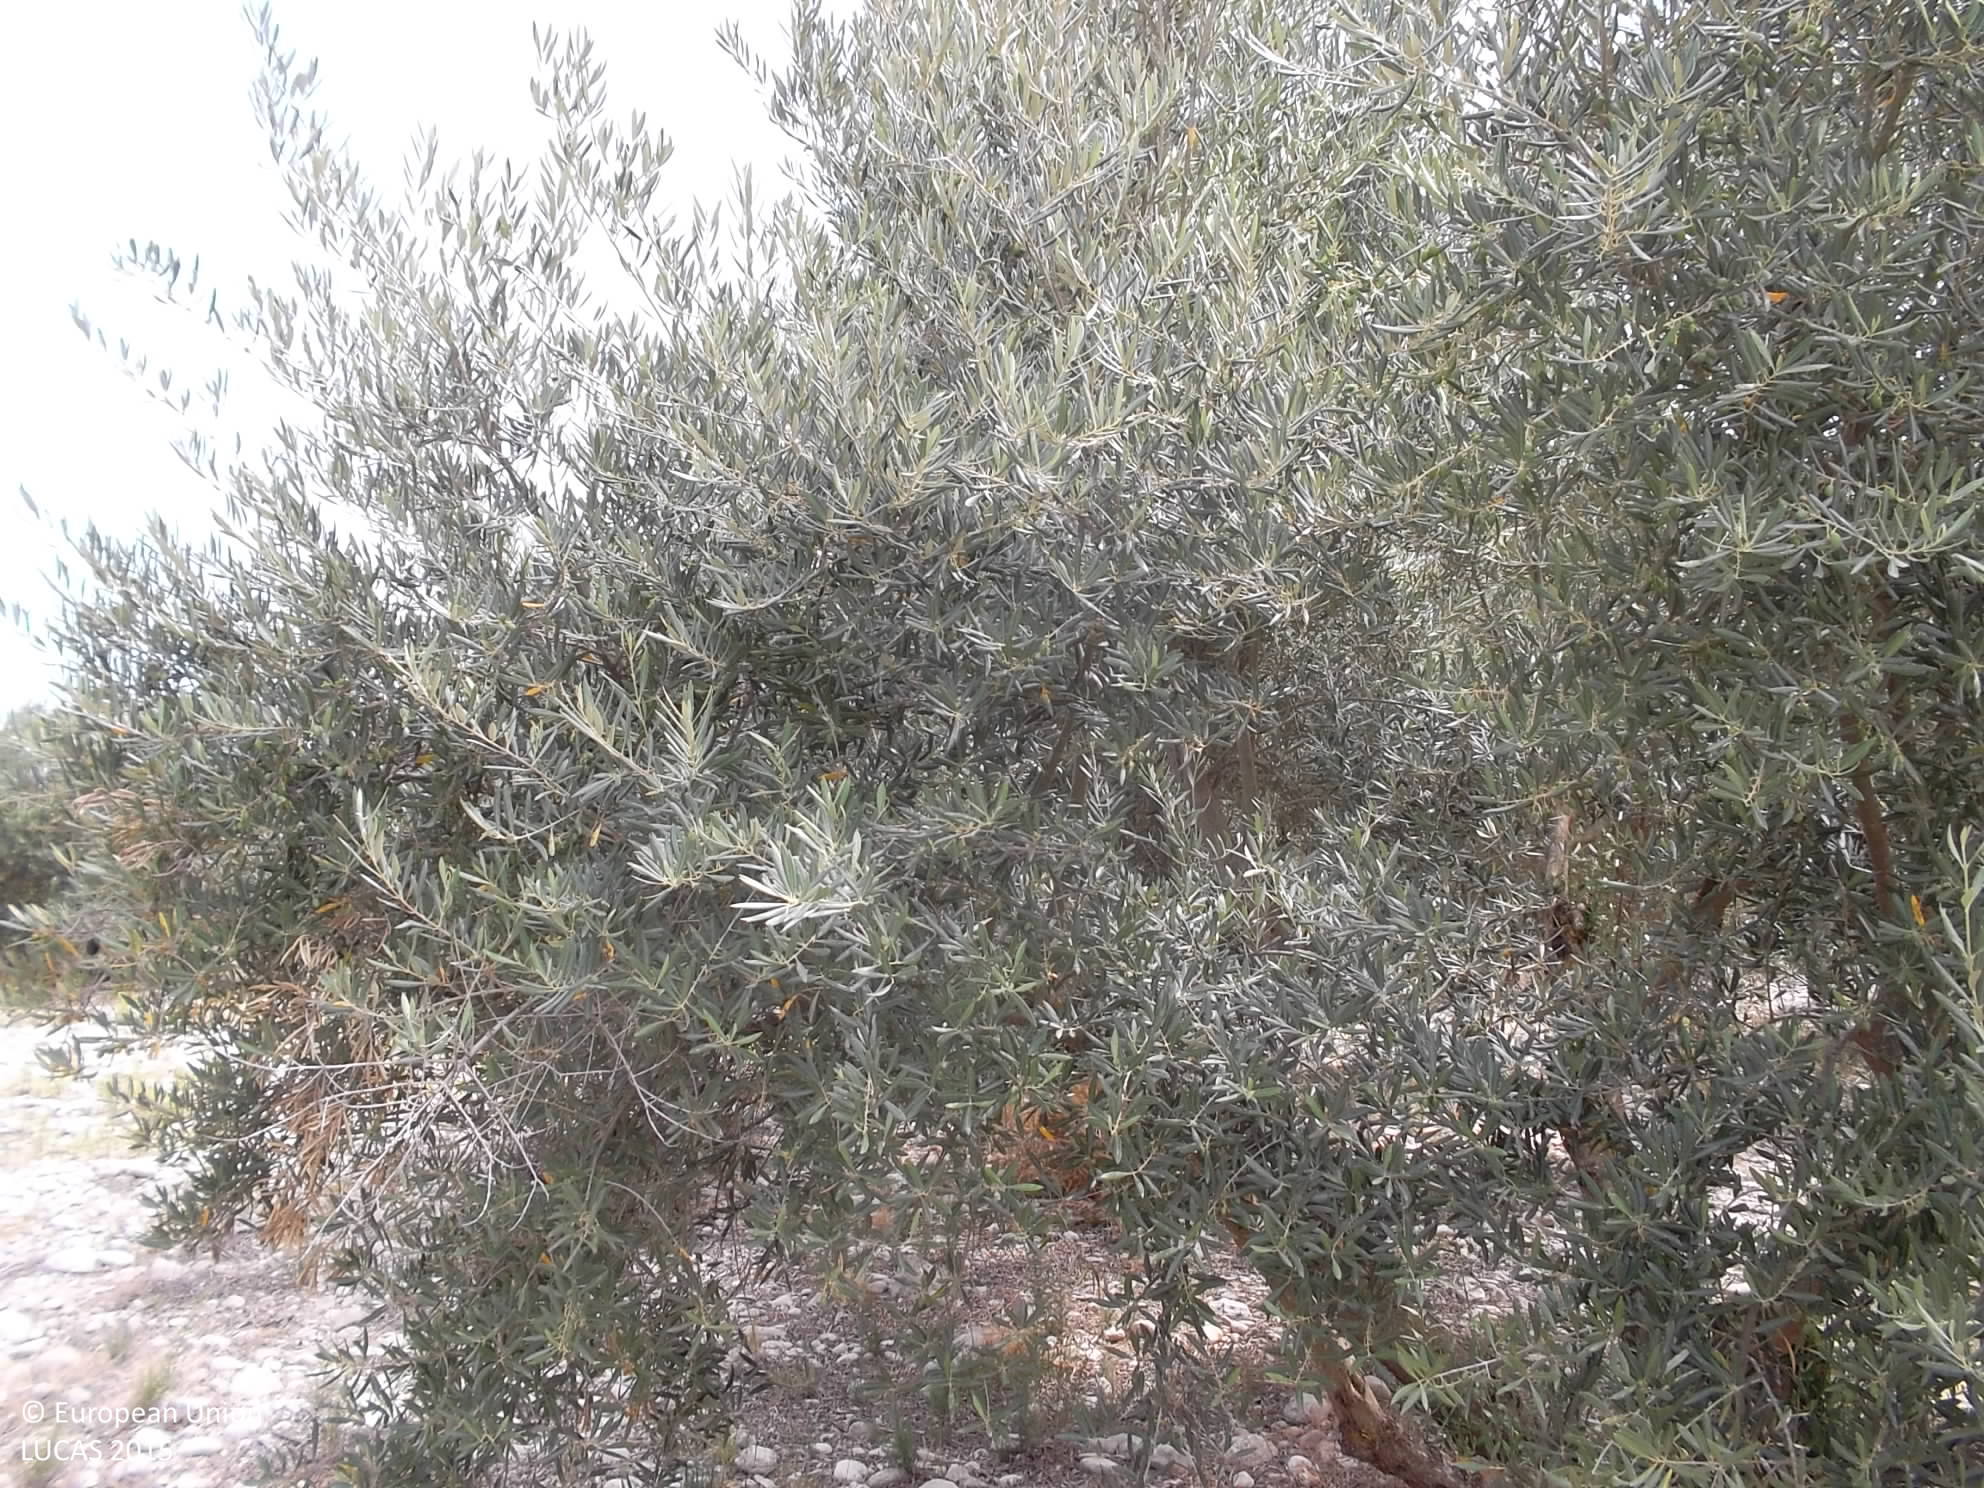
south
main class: Cropland
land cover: Olive groves
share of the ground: 50 - 75 %
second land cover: Other bare soil
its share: > 75 %
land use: Agriculture (excluding fallow land and kitchen gardens)
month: July
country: ES
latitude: 37.6001
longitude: -2.7537
